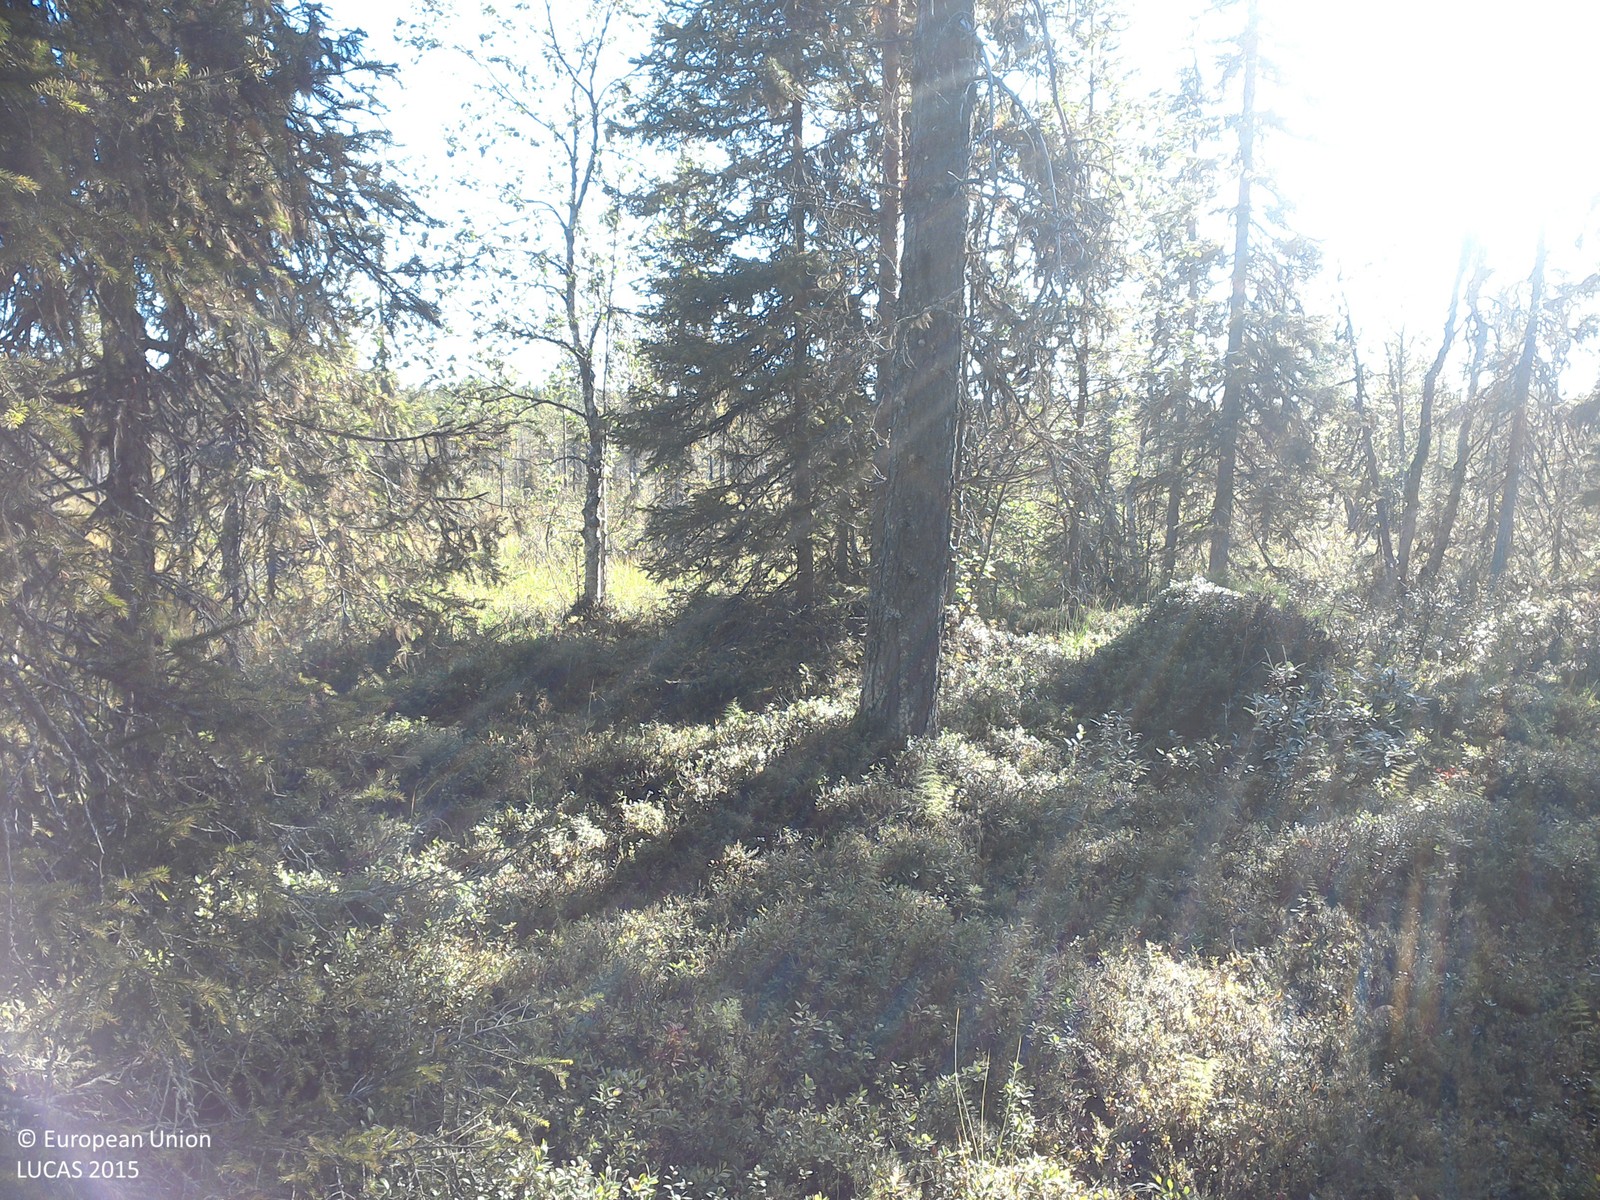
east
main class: Woodland
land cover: Spruce dominated mixed woodland
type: boreal forest
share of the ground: 25 - 50 %
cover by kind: shrubs 65 %, coniferous forest trees 20 %, broadleaved forest trees 10 %, lichens and mosses 5 %
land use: Forestry
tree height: > 5 m
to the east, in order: Spruce dominated mixed woodland; Pine dominated coniferous woodland; Other coniferous woodland; Spruce dominated mixed woodland; Other mixed woodland
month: August
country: SE
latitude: 67.1023
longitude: 21.3544
